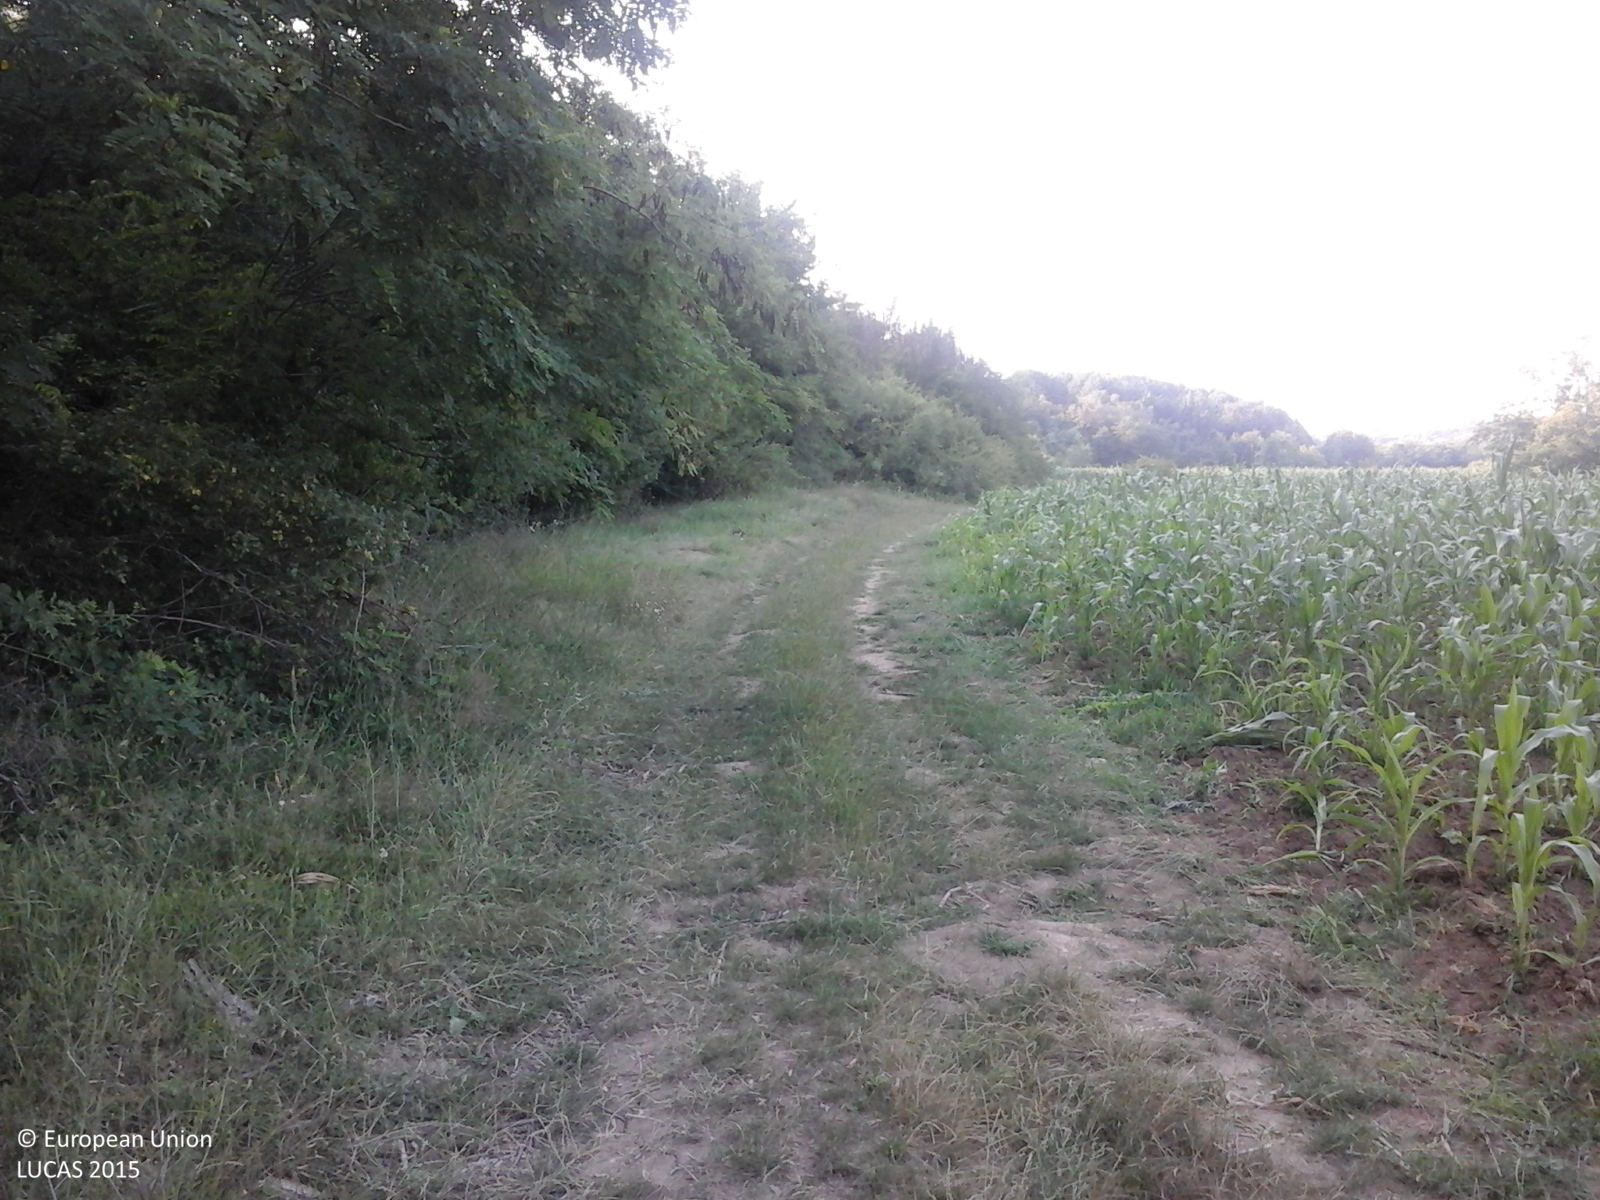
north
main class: Cropland
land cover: Maize
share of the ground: > 75 %
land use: Agriculture (excluding fallow land and kitchen gardens)
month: July
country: RO
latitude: 44.8081
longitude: 24.7583
